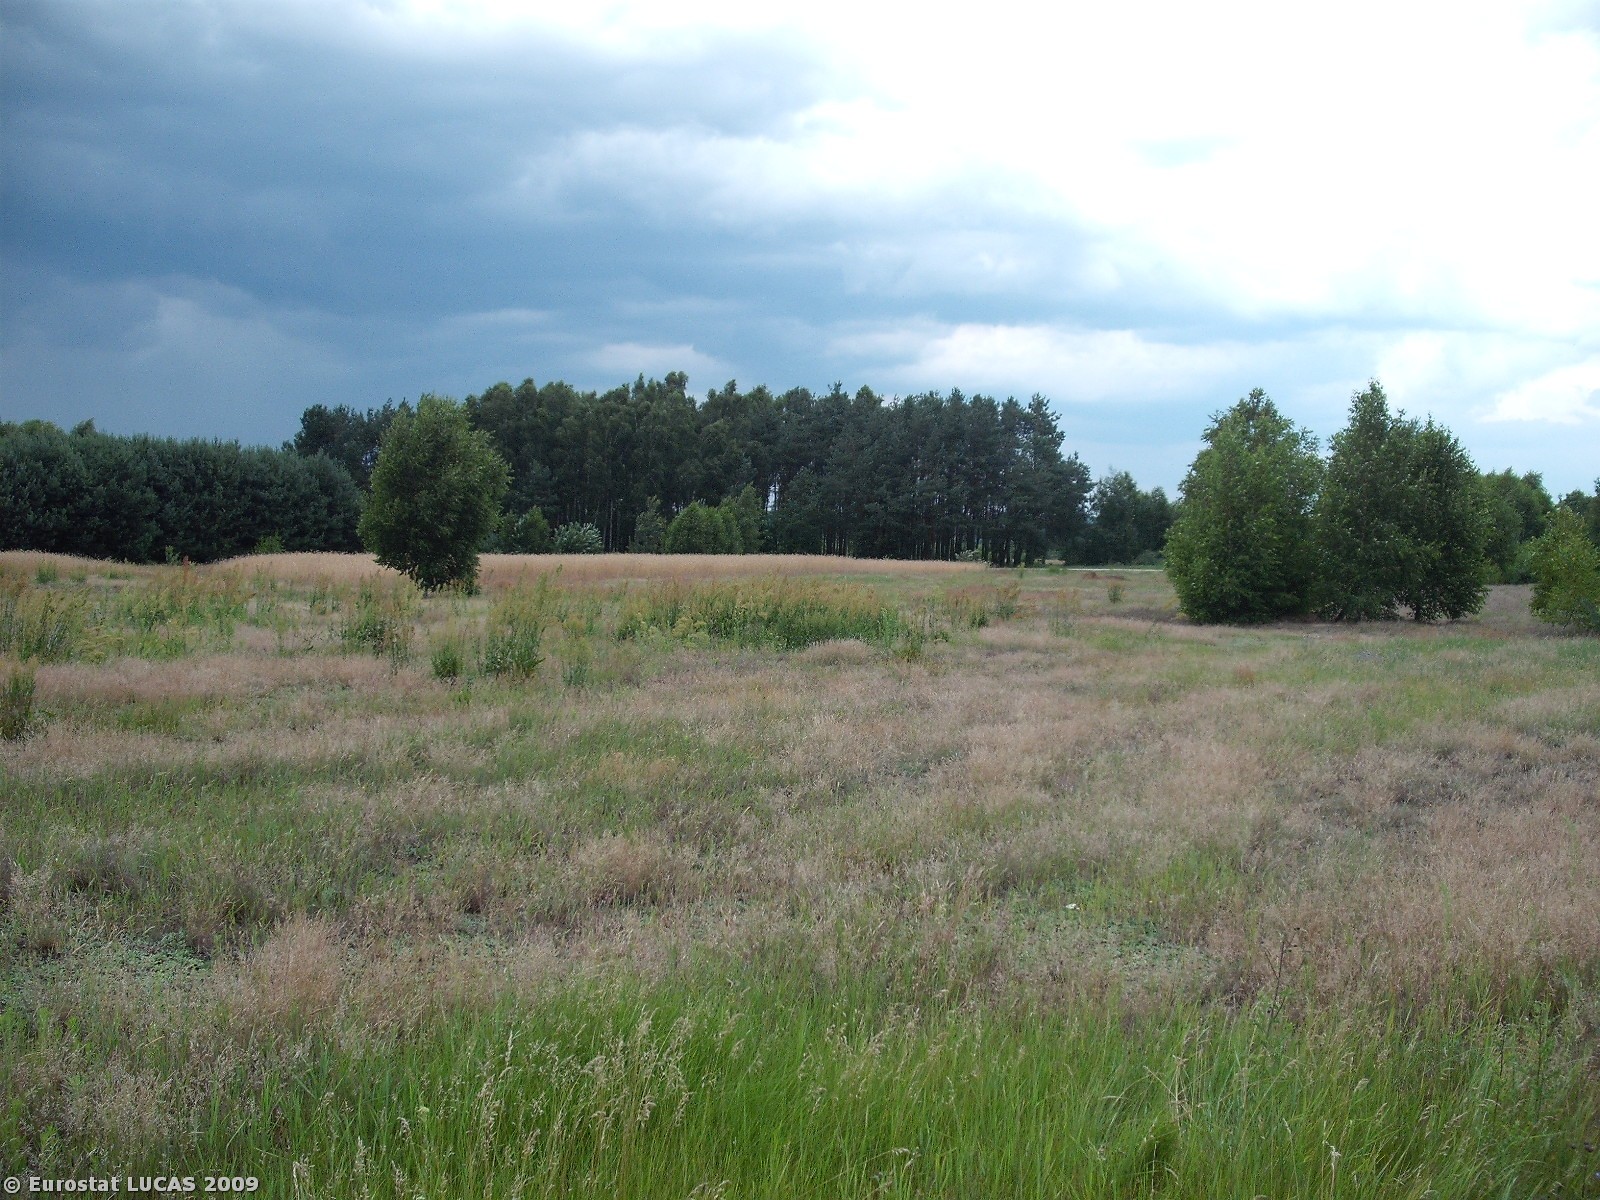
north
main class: Grassland
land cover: Grassland with sparse tree/shrub cover
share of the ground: > 75 %
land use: Unused
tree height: < 5 m
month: July
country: PL
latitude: 51.4777
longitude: 21.0601
